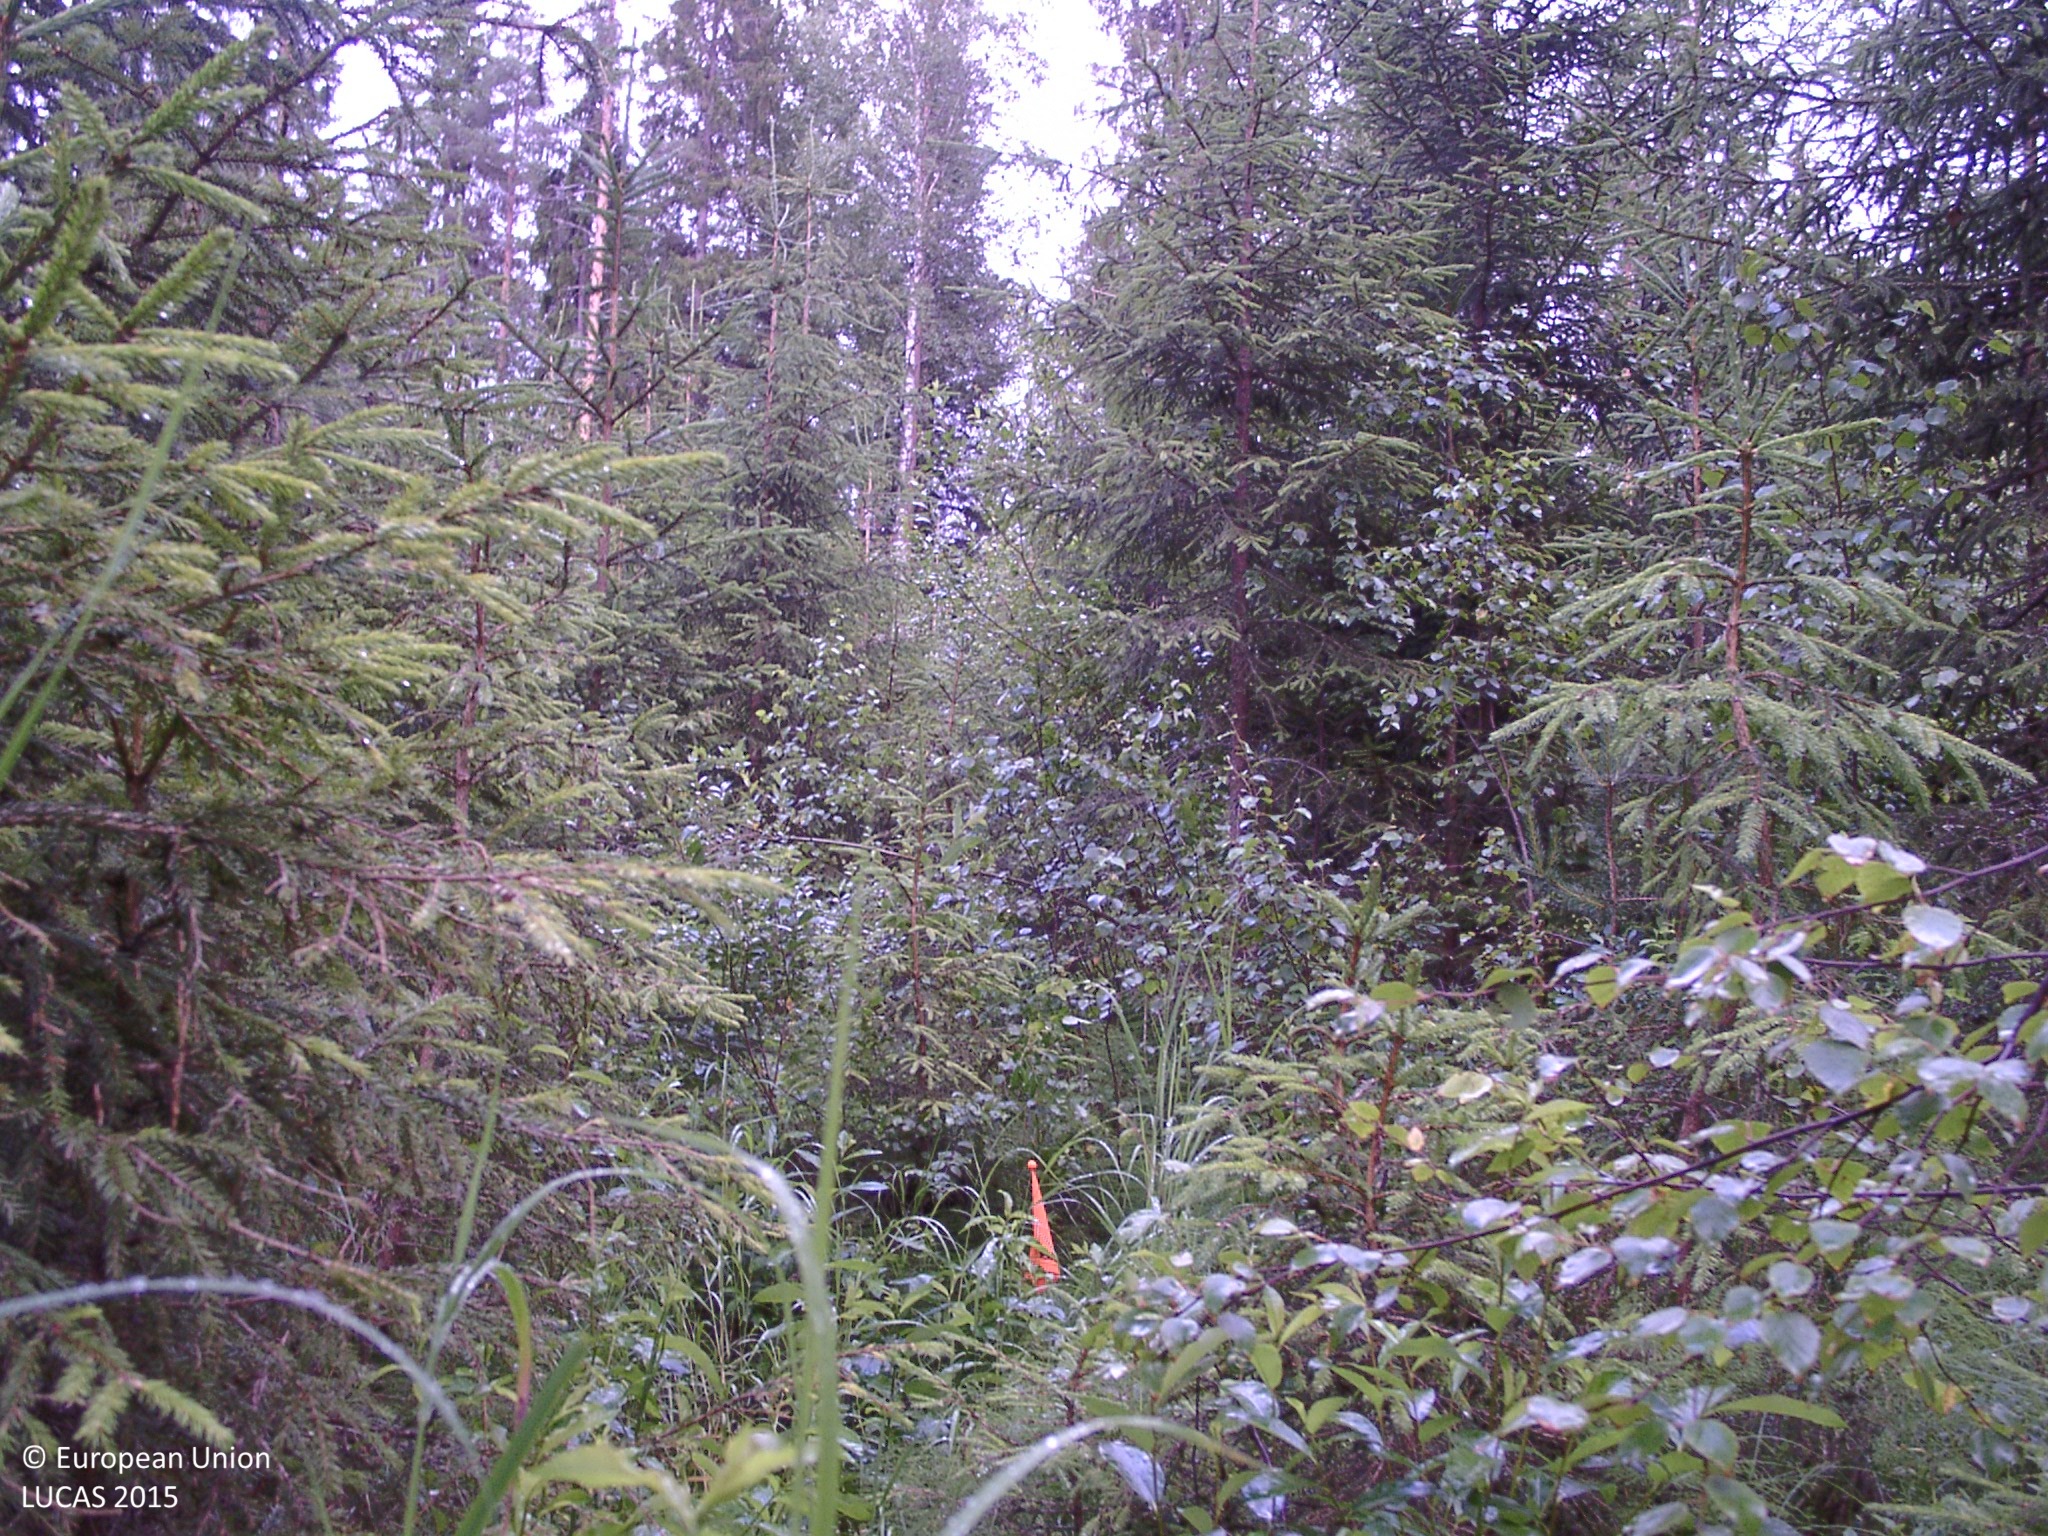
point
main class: Woodland
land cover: Spruce dominated mixed woodland
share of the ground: 50 - 75 %
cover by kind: coniferous forest trees 40 %, broadleaved forest trees 20 %, shrubs 20 %, herbaceous plants 5 %, lichens and mosses 5 %, unconsolidated bare surface 5 %
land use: Forestry
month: July
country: FI
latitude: 62.3255
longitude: 25.2582
